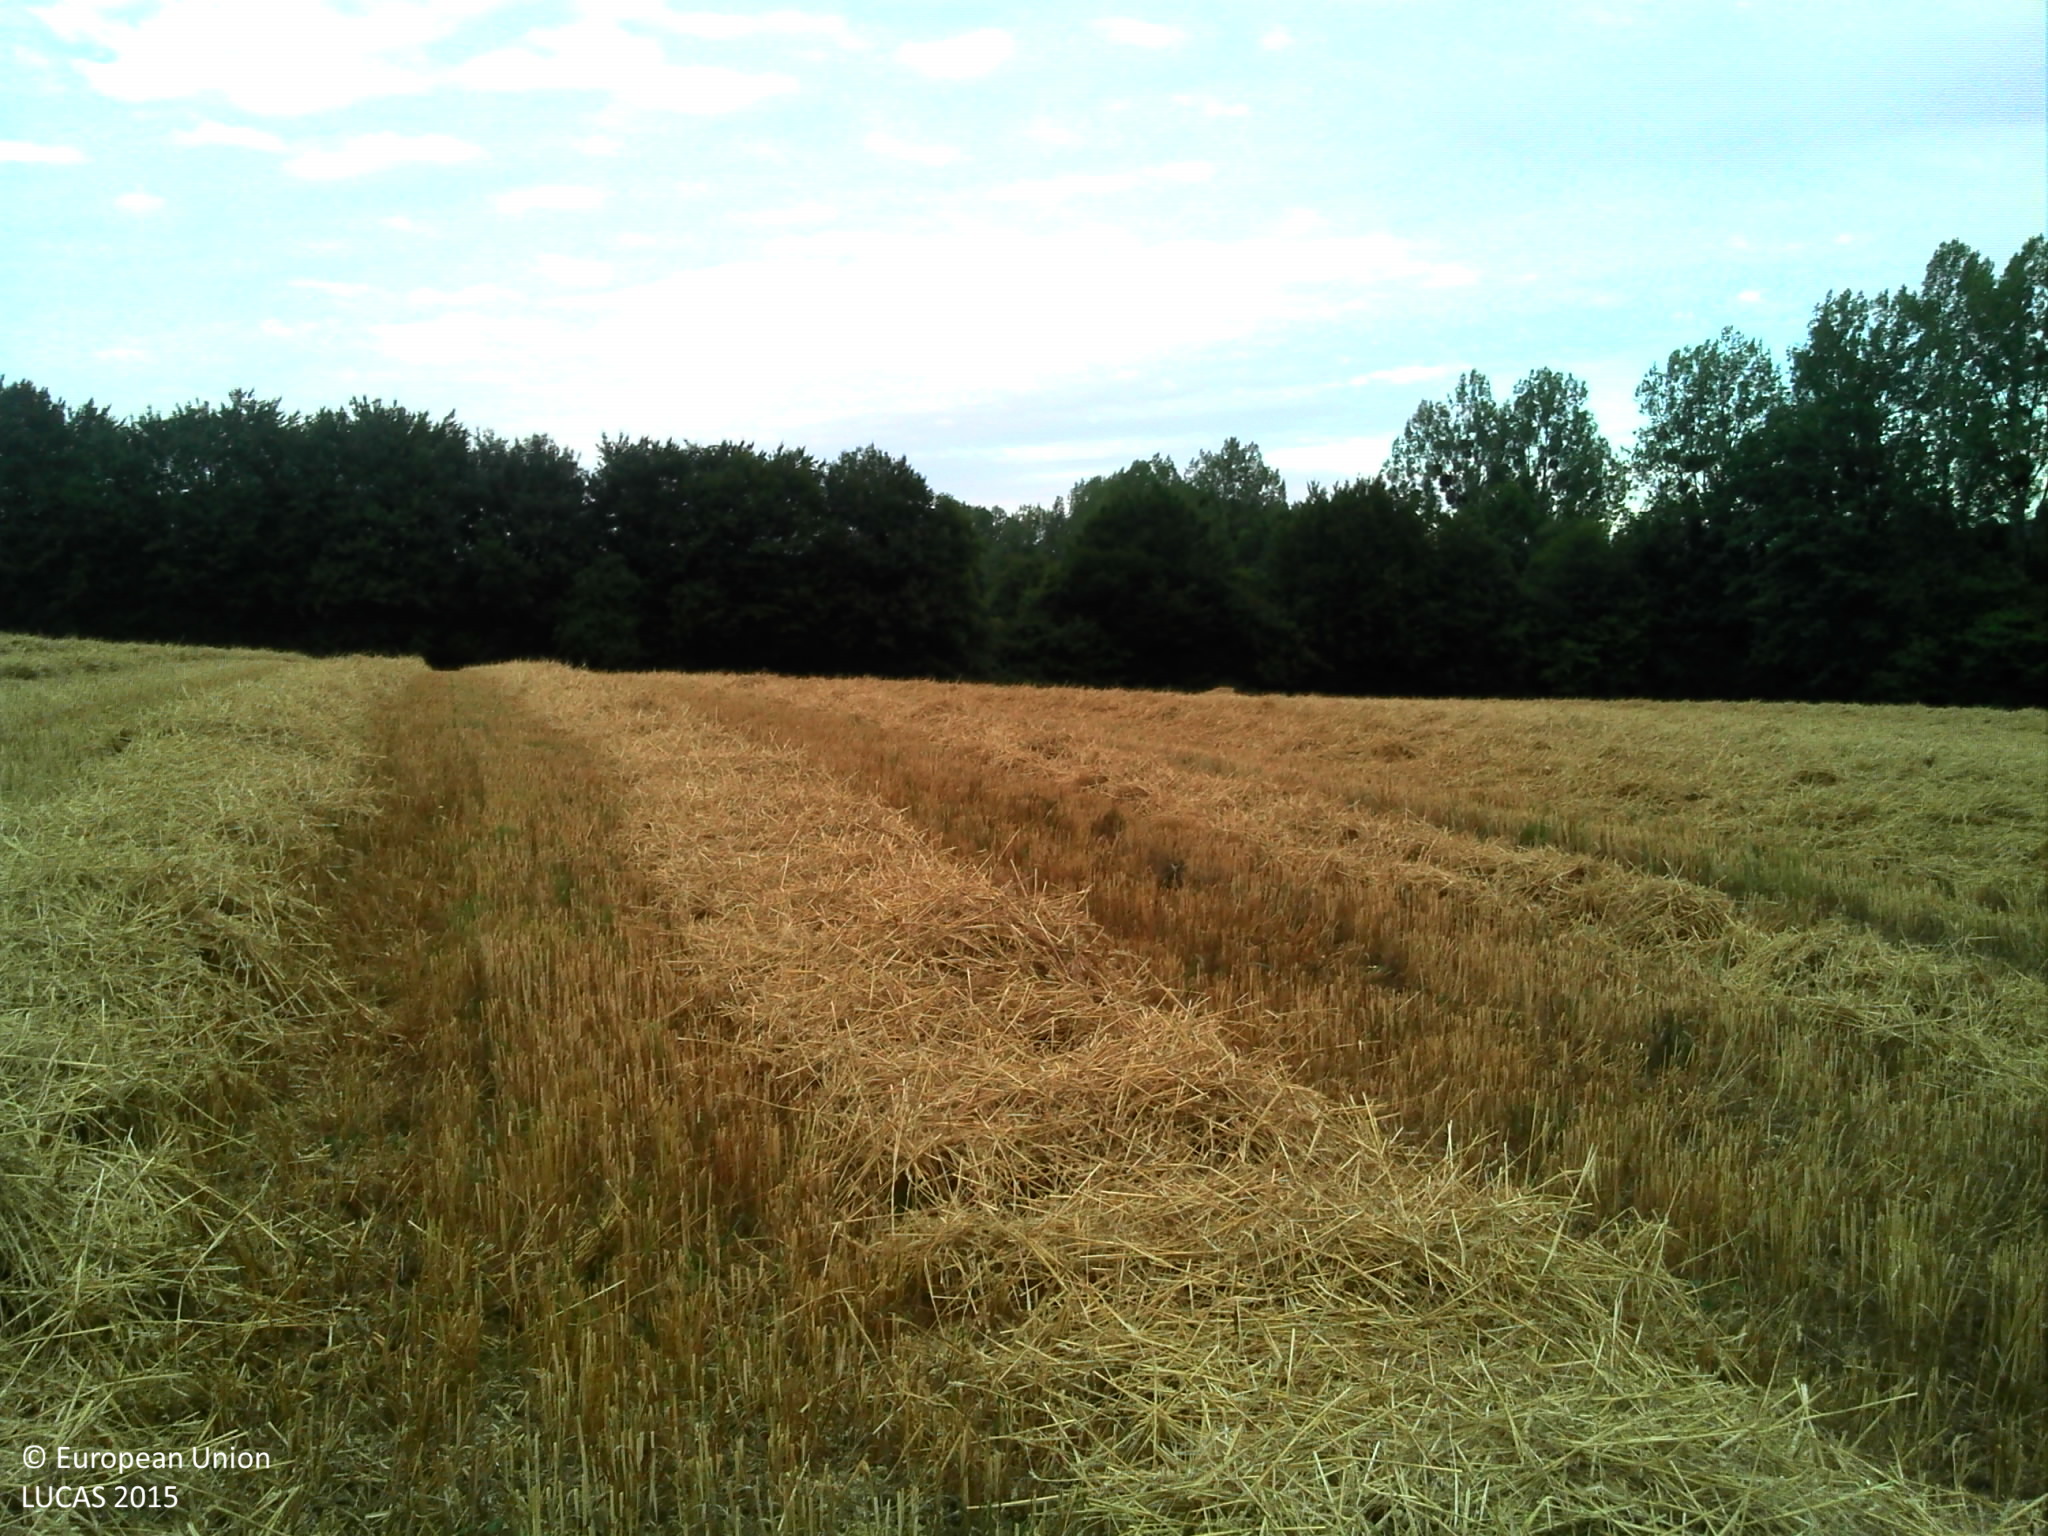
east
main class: Cropland
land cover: Common wheat
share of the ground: > 75 %
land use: Agriculture (excluding fallow land and kitchen gardens)
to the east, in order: Common wheat; Broadleaved woodland; Grassland with sparse tree/shrub cover; Grassland without tree/shrub cover
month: July
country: FR
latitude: 48.6470
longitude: 0.5145
